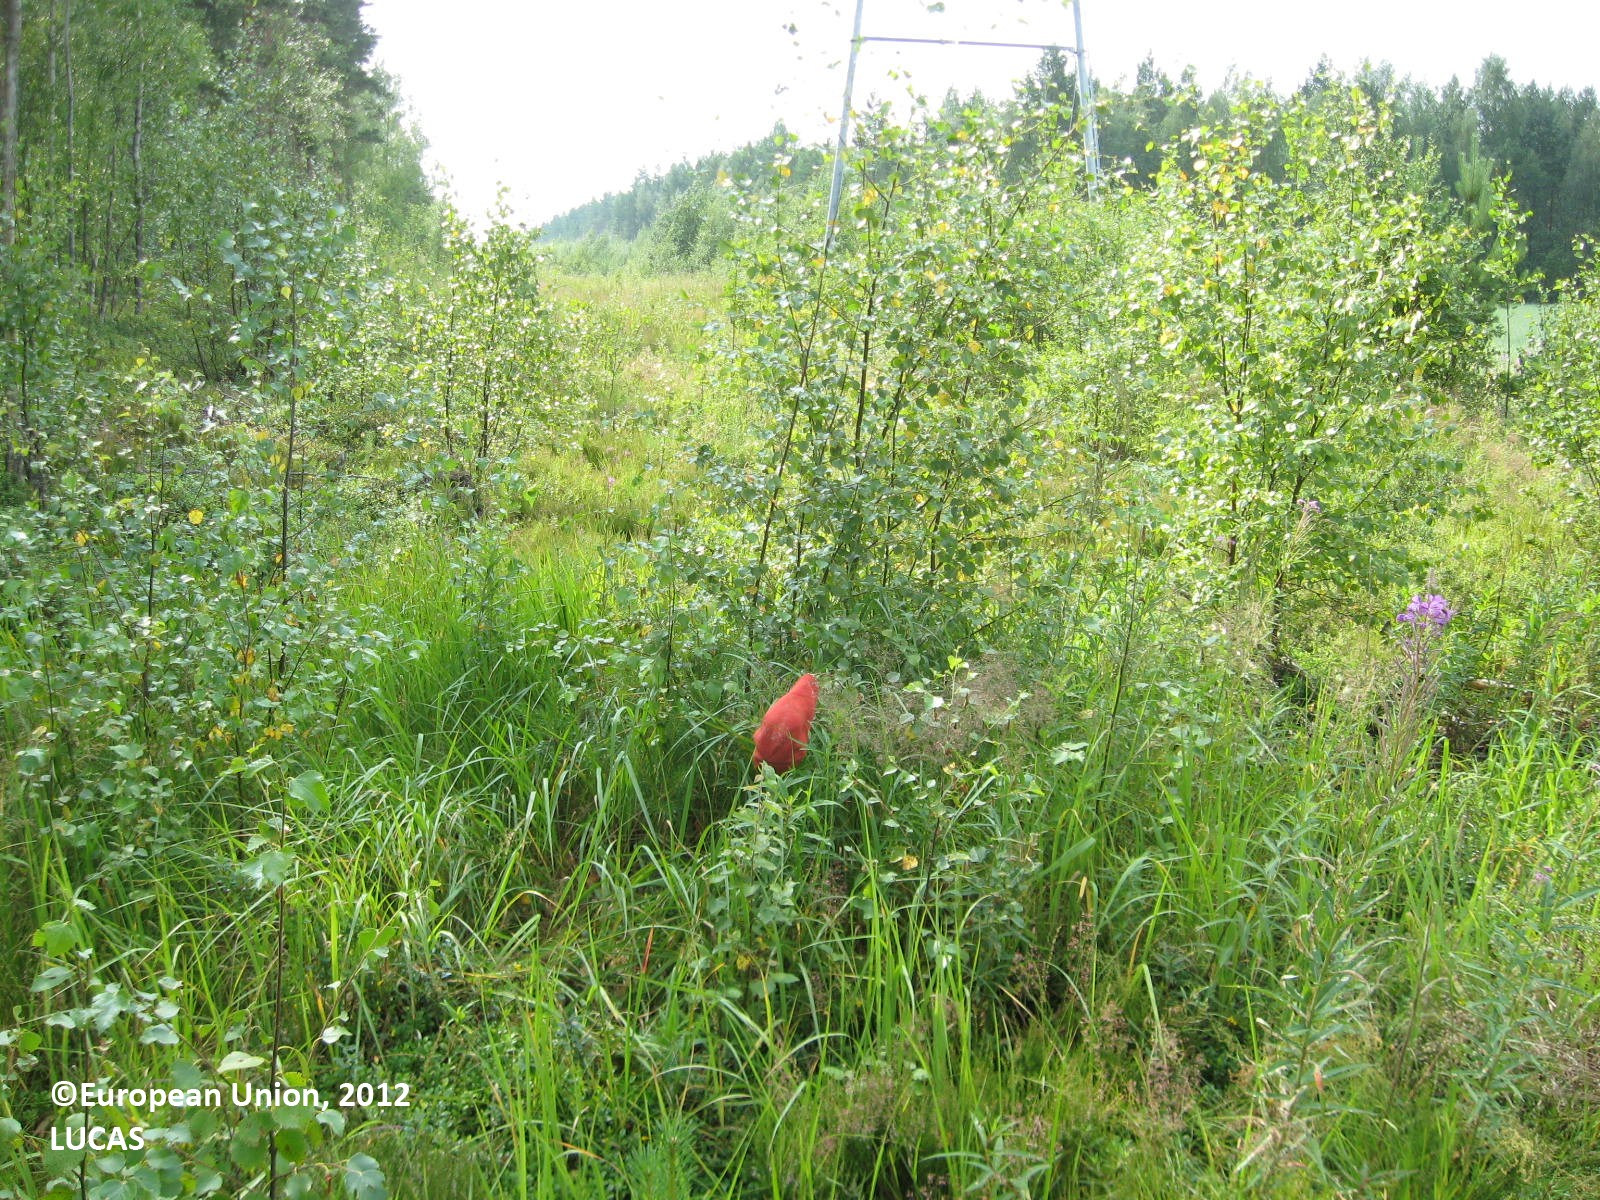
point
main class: Woodland
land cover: Other mixed woodland
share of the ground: 50 - 75 %
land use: Energy production
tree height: < 5 m
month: July
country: FI
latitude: 61.9518
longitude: 22.3927
